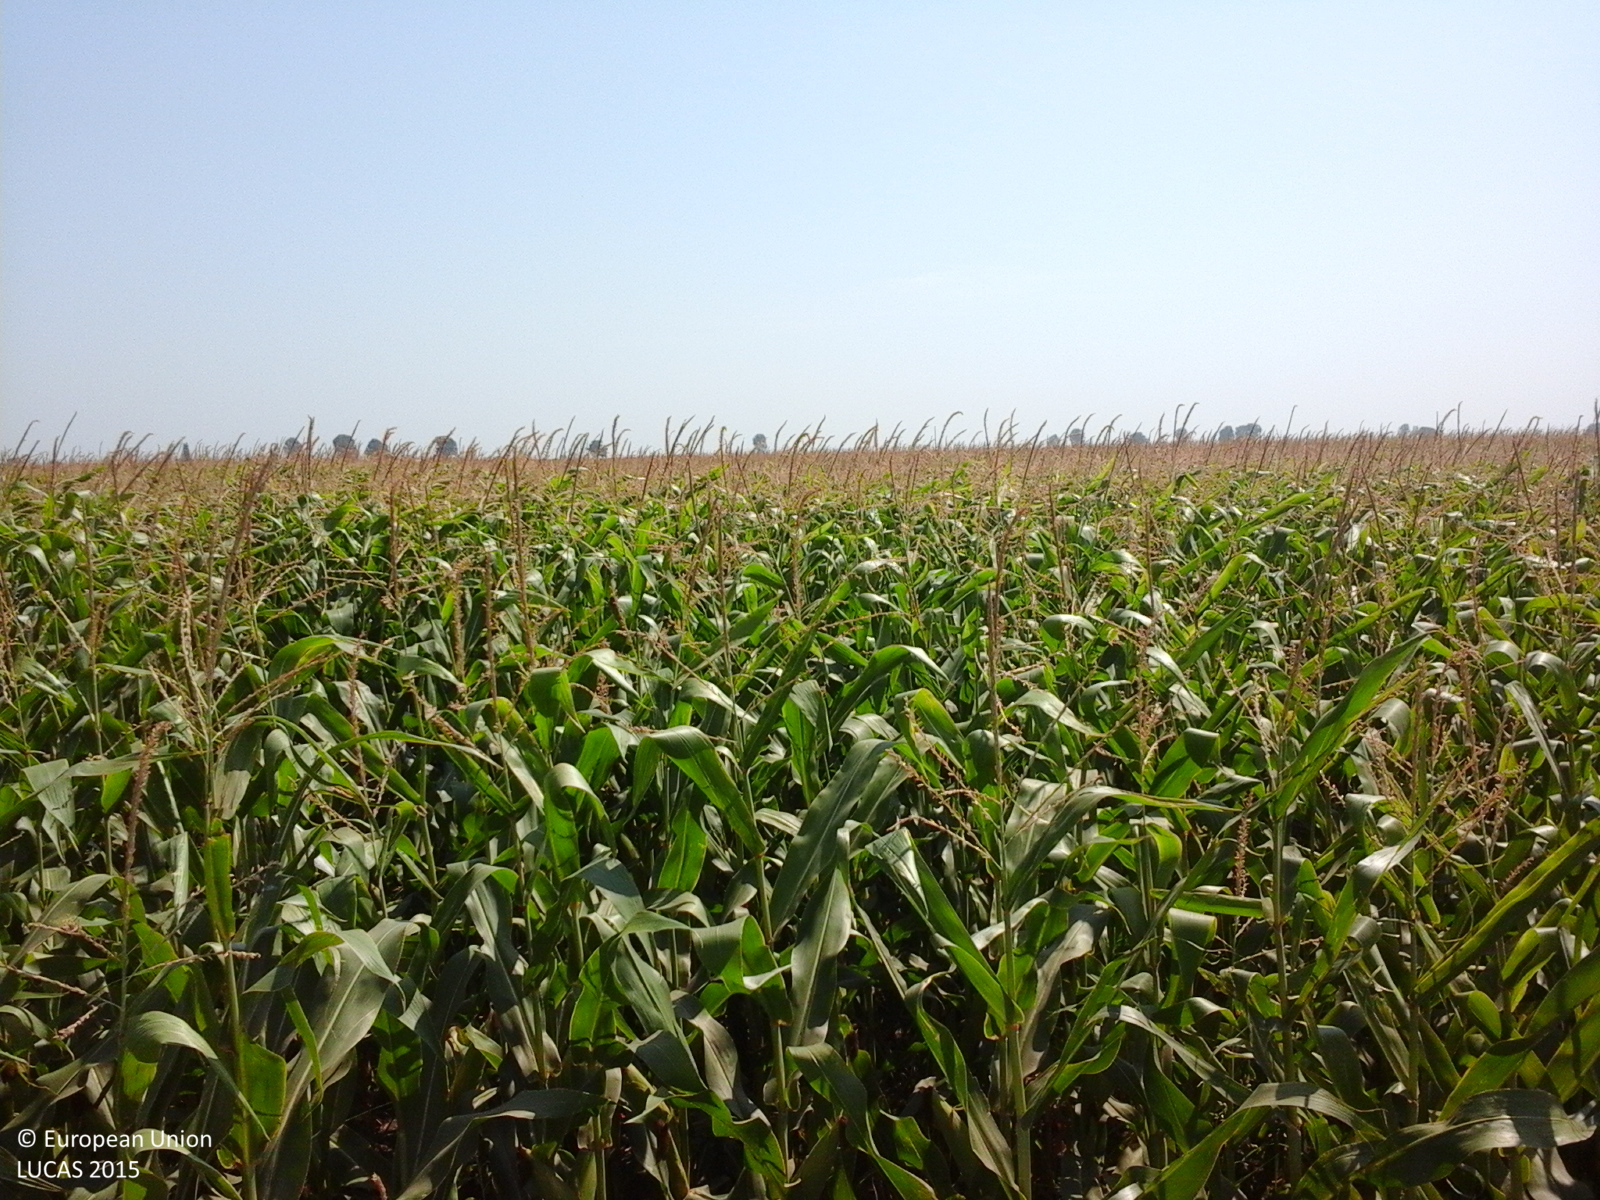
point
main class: Cropland
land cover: Maize
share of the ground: > 75 %
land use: Agriculture (excluding fallow land and kitchen gardens)
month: August
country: RO
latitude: 45.1798
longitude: 27.4428
